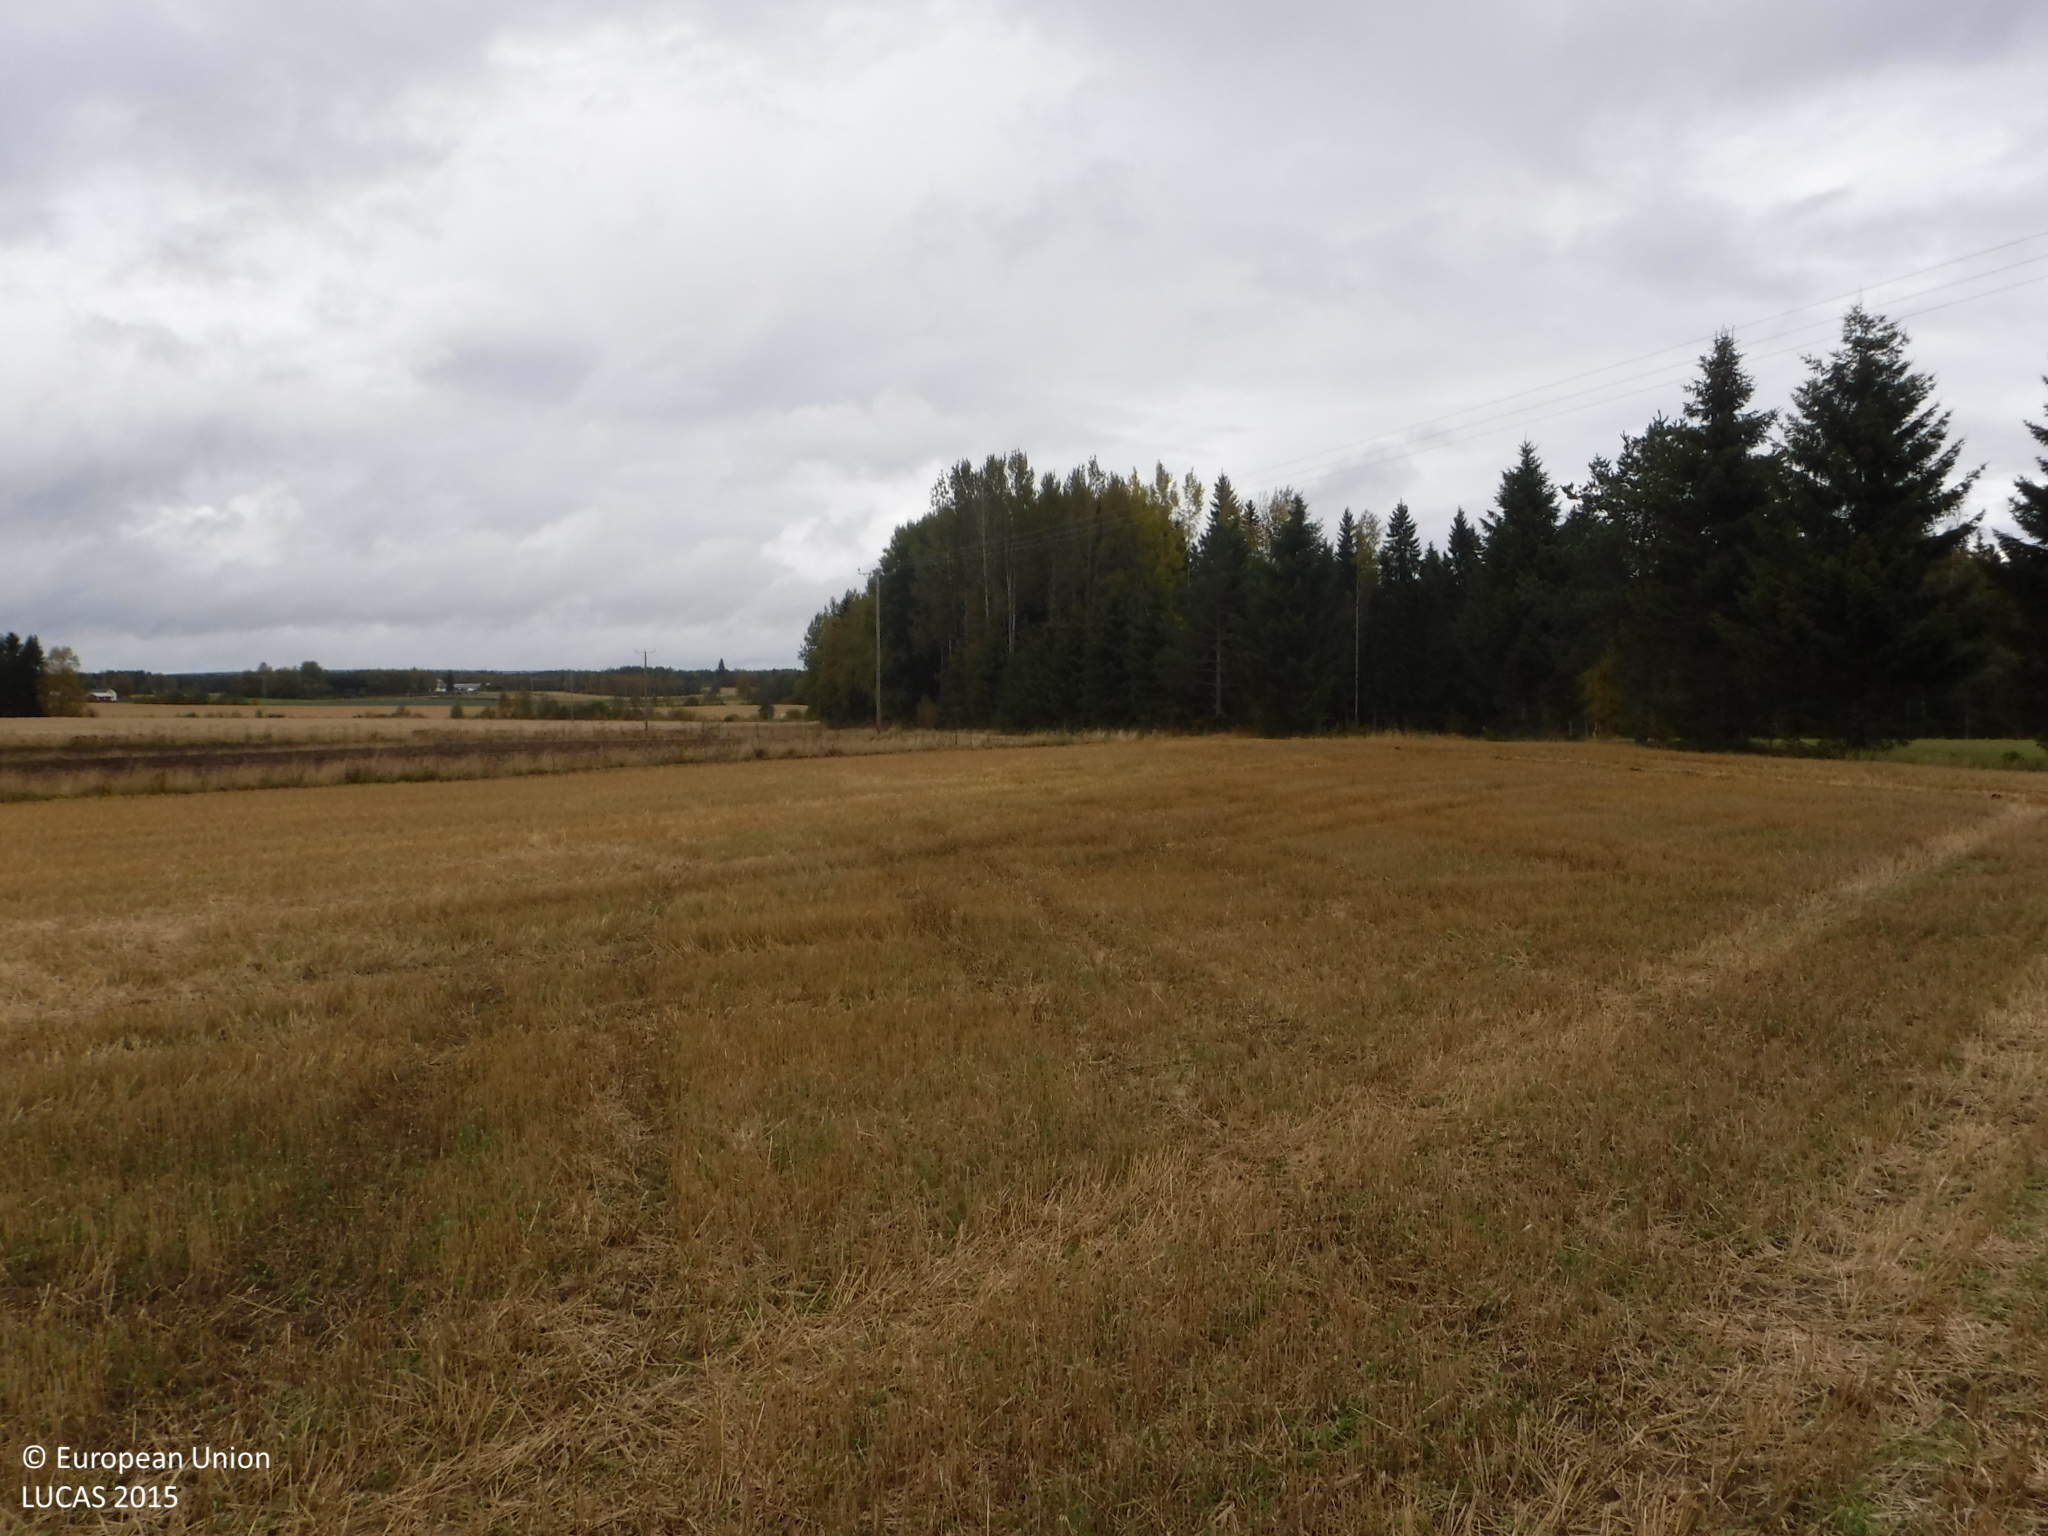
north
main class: Cropland
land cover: Barley
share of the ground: > 75 %
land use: Agriculture (excluding fallow land and kitchen gardens)
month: September
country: FI
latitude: 62.0914
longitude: 22.2549
